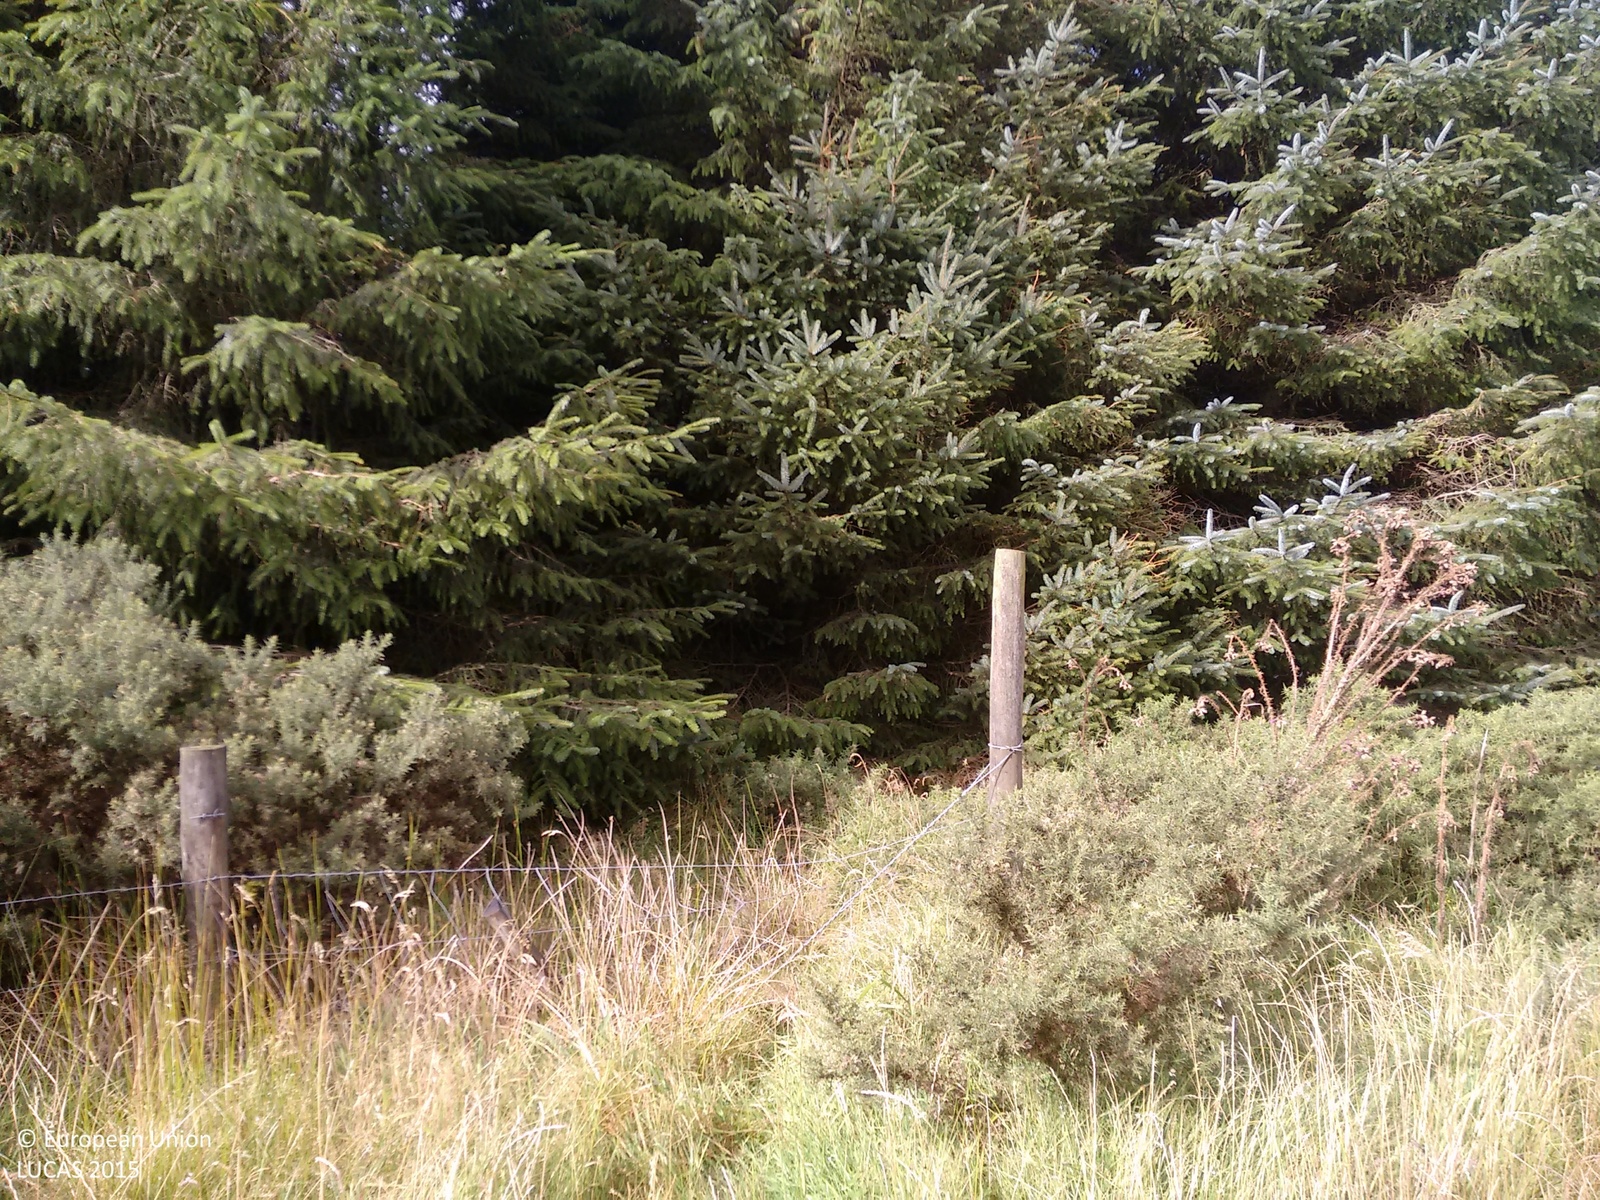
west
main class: Woodland
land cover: Spruce dominated coniferous woodland
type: exotic forest
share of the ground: > 75 %
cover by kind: coniferous forest trees 100 %
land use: Forestry
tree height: > 5 m
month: September
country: IE
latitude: 55.1726
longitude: -7.2428
